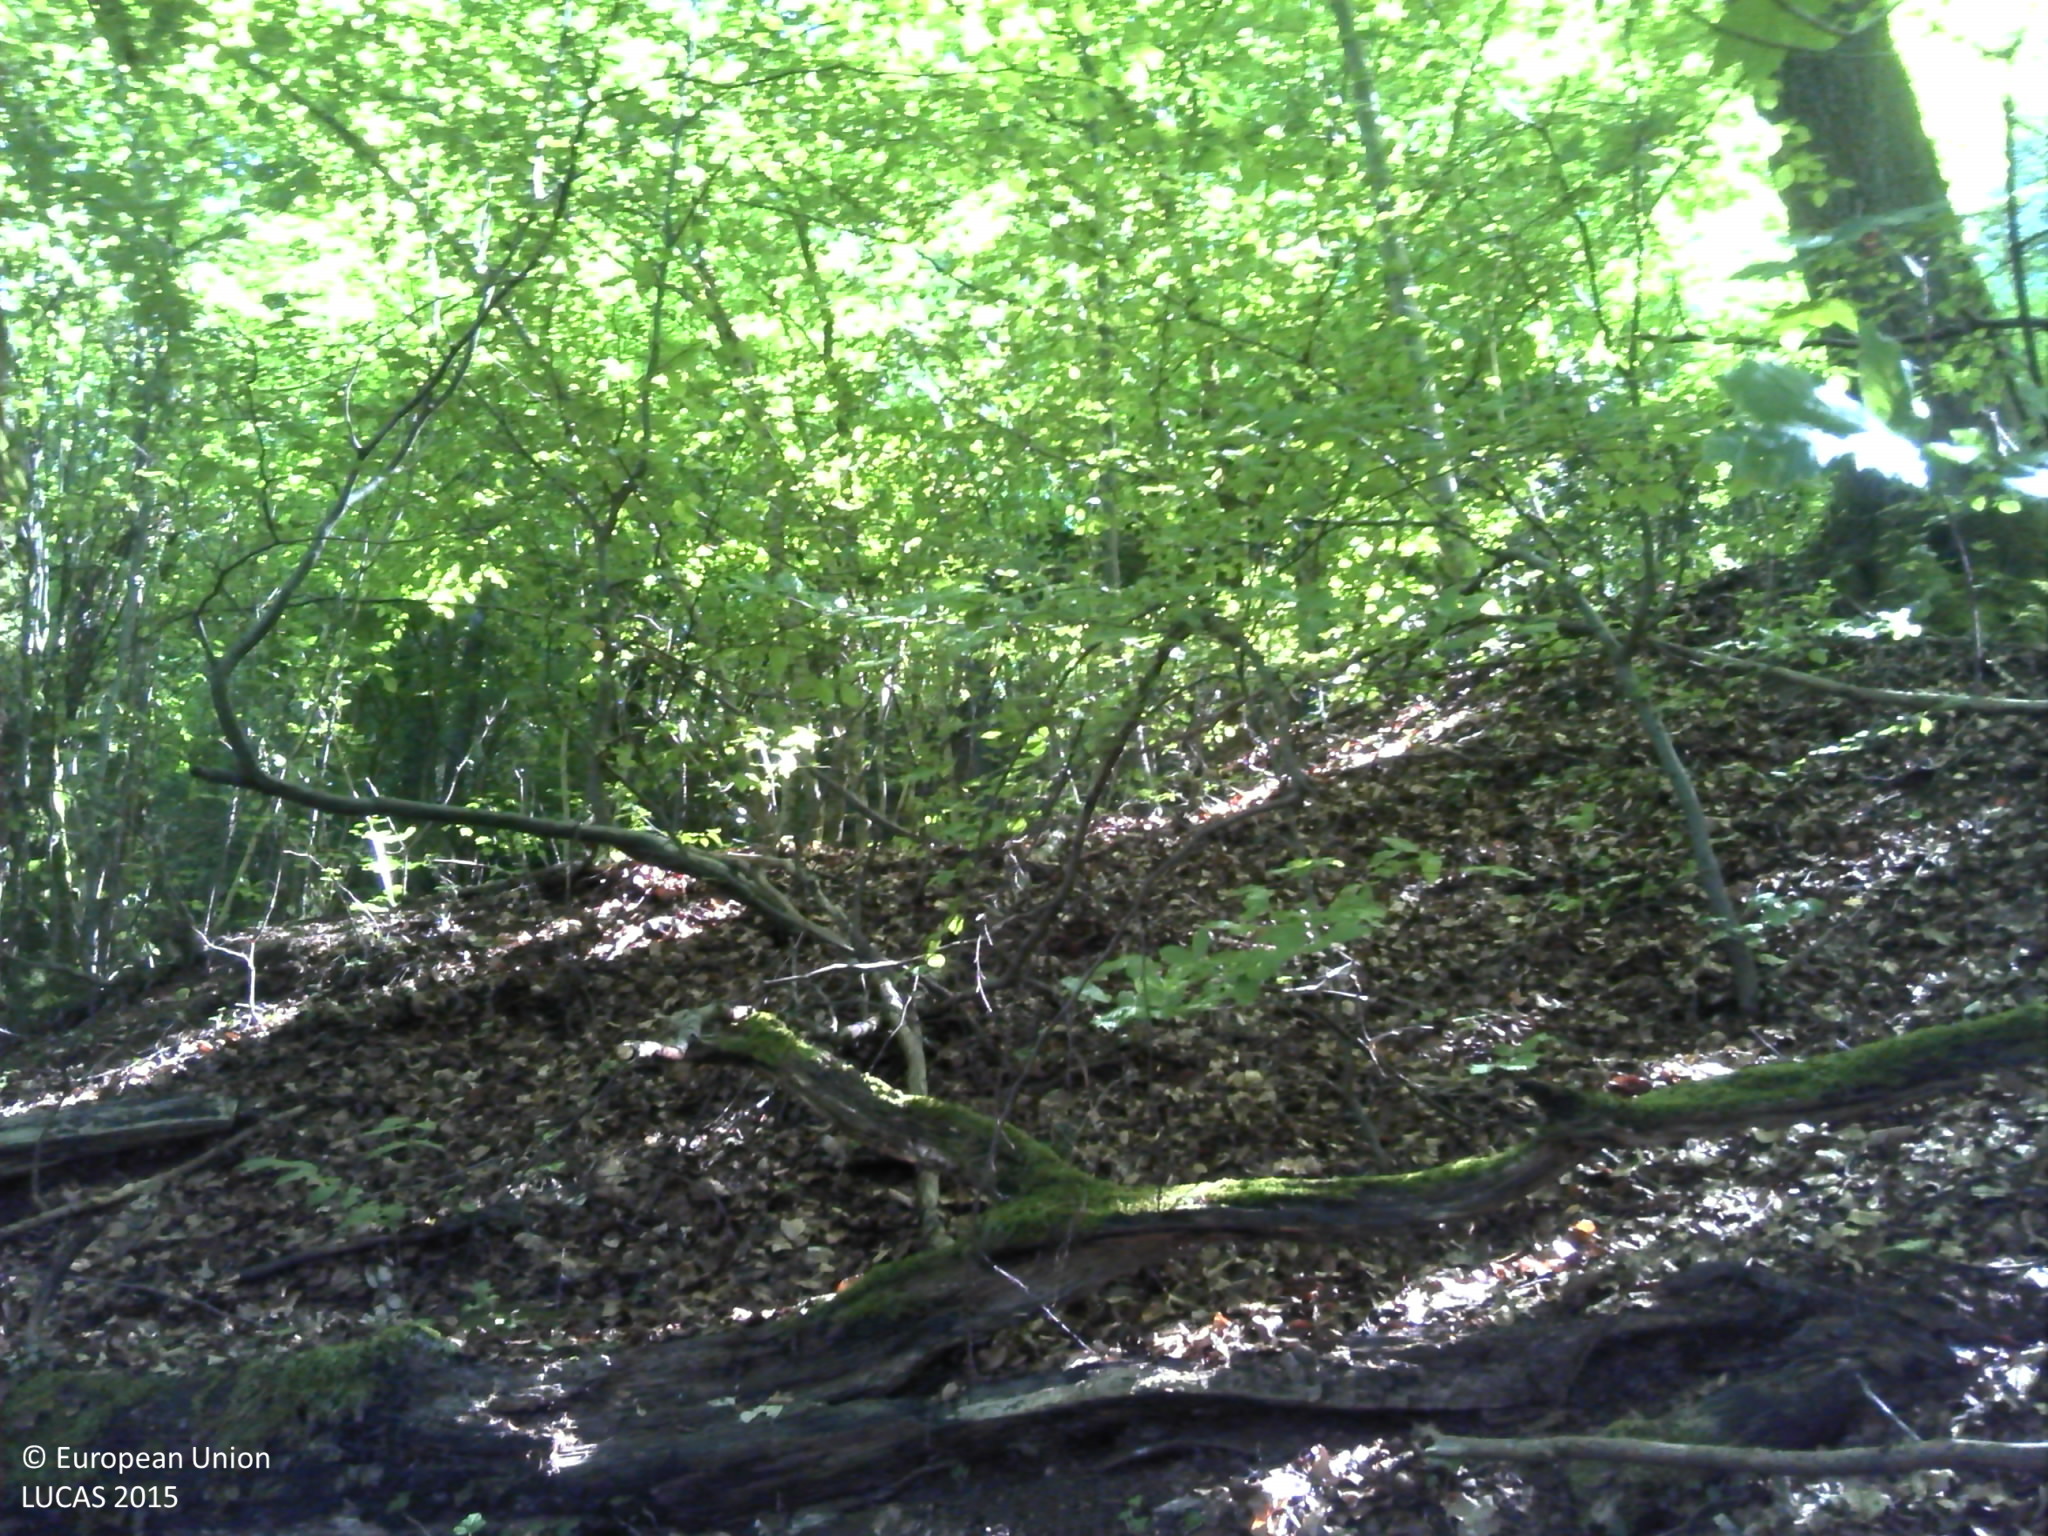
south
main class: Woodland
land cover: Broadleaved woodland
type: acidophilous oak and oak-birch forest
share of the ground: > 75 %
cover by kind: broadleaved forest trees 100 %
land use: Forestry
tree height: > 5 m
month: June
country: FR
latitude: 49.4643
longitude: 5.9565
